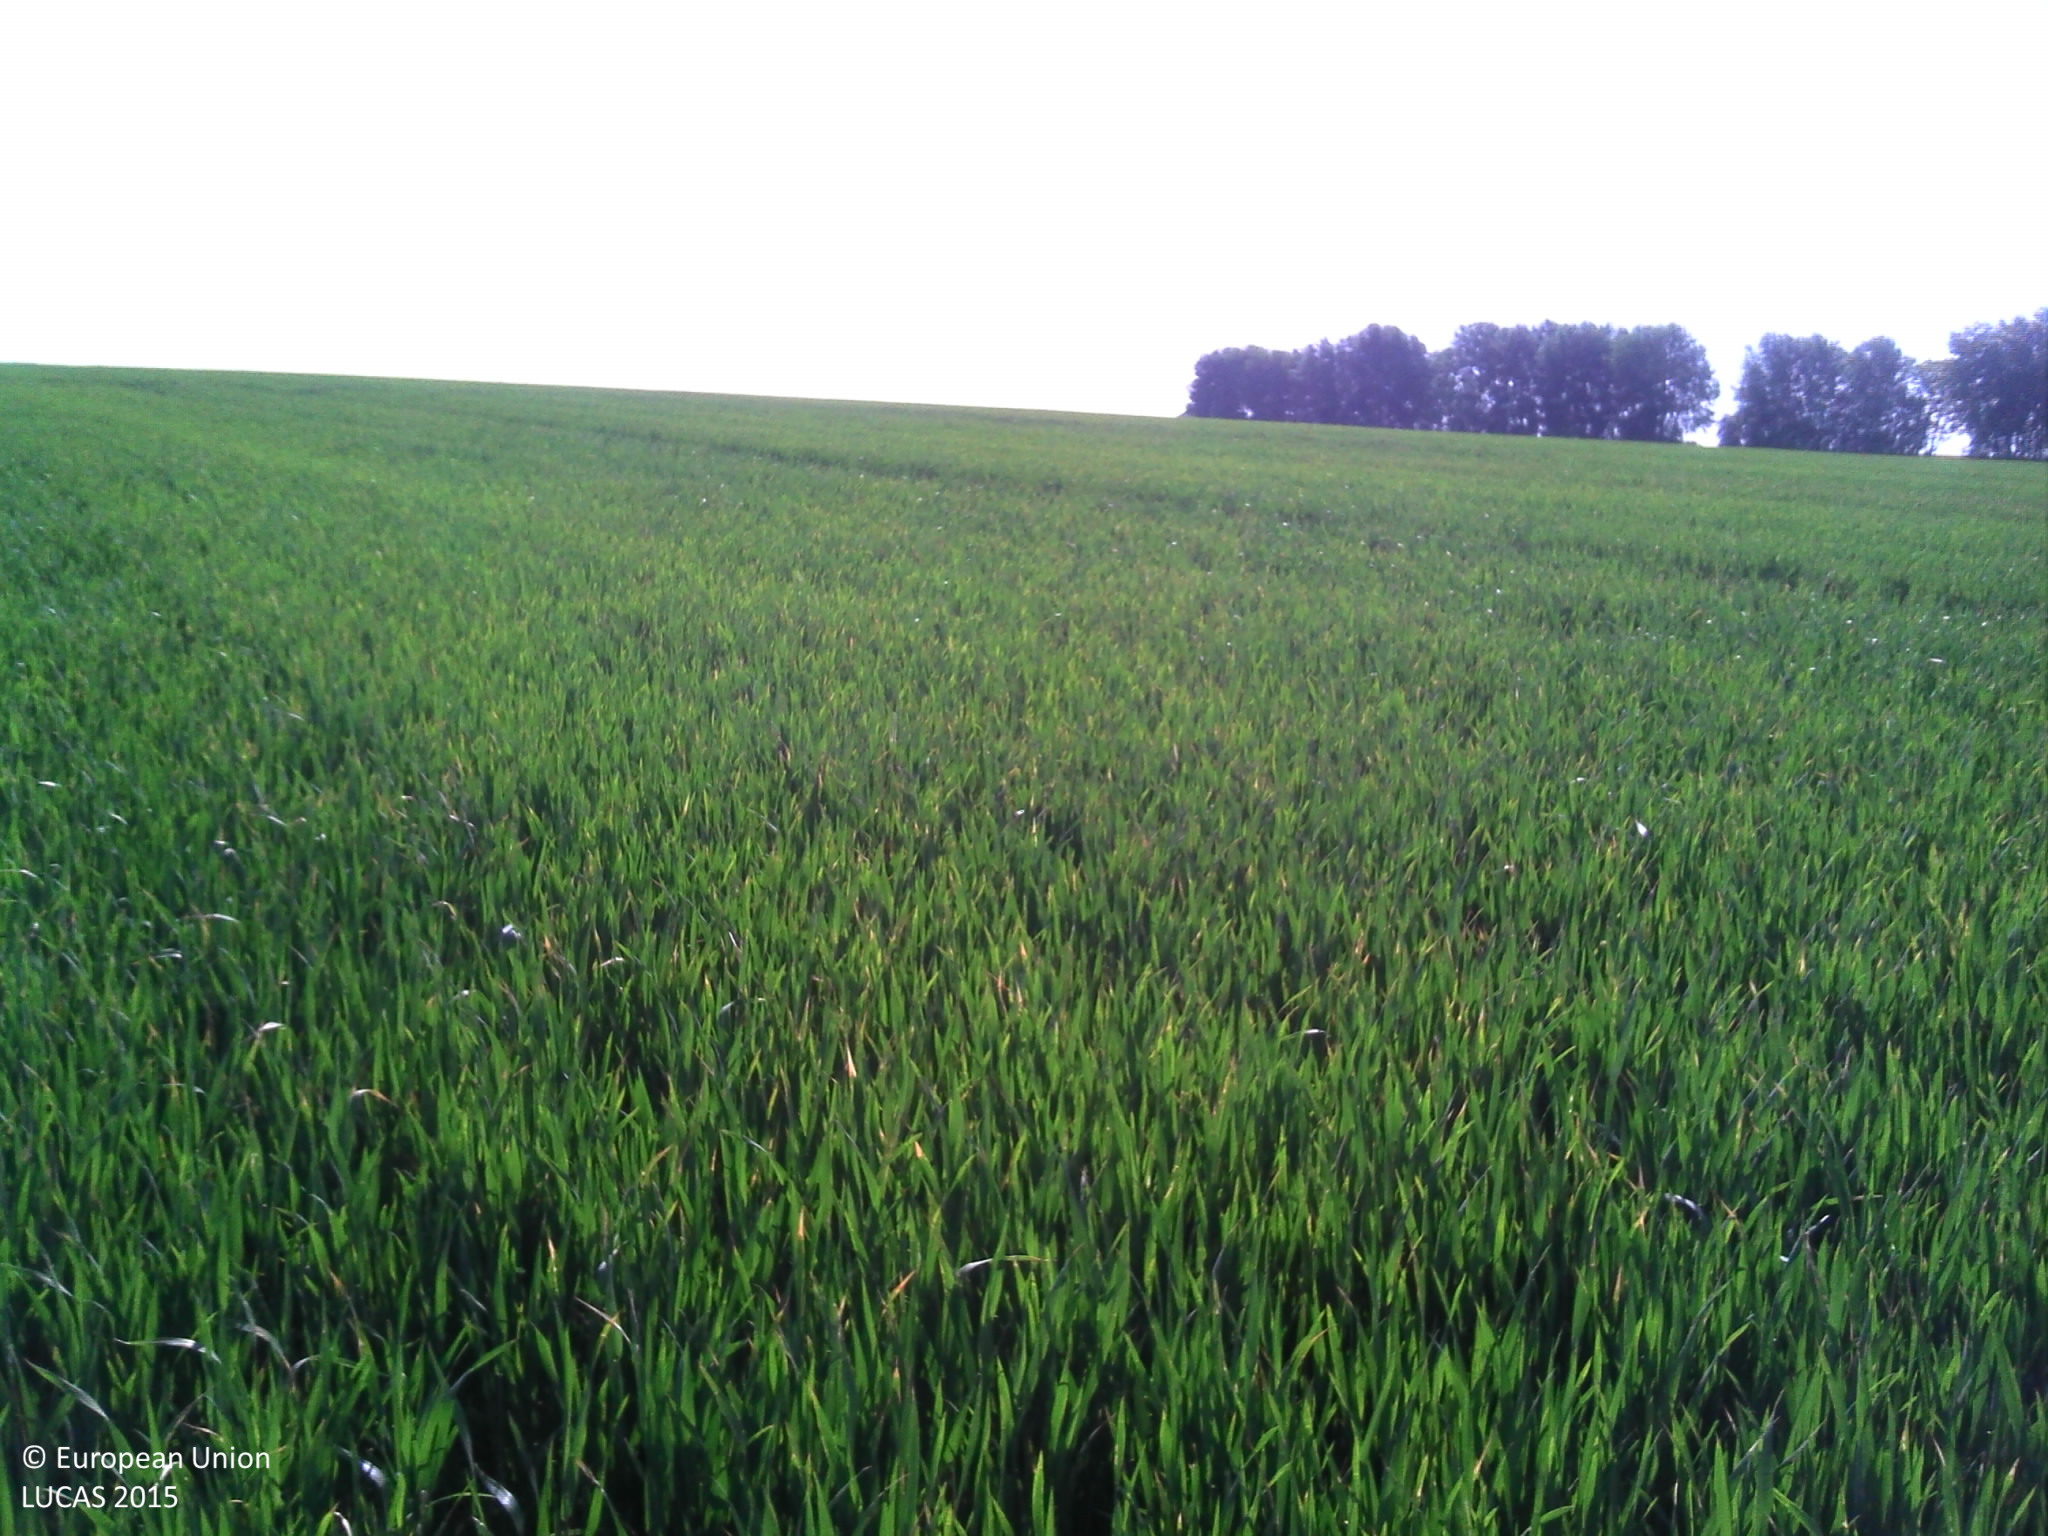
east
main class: Cropland
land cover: Common wheat
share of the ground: > 75 %
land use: Agriculture (excluding fallow land and kitchen gardens)
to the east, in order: Common wheat
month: May
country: BE
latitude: 50.5631
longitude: 4.6458
